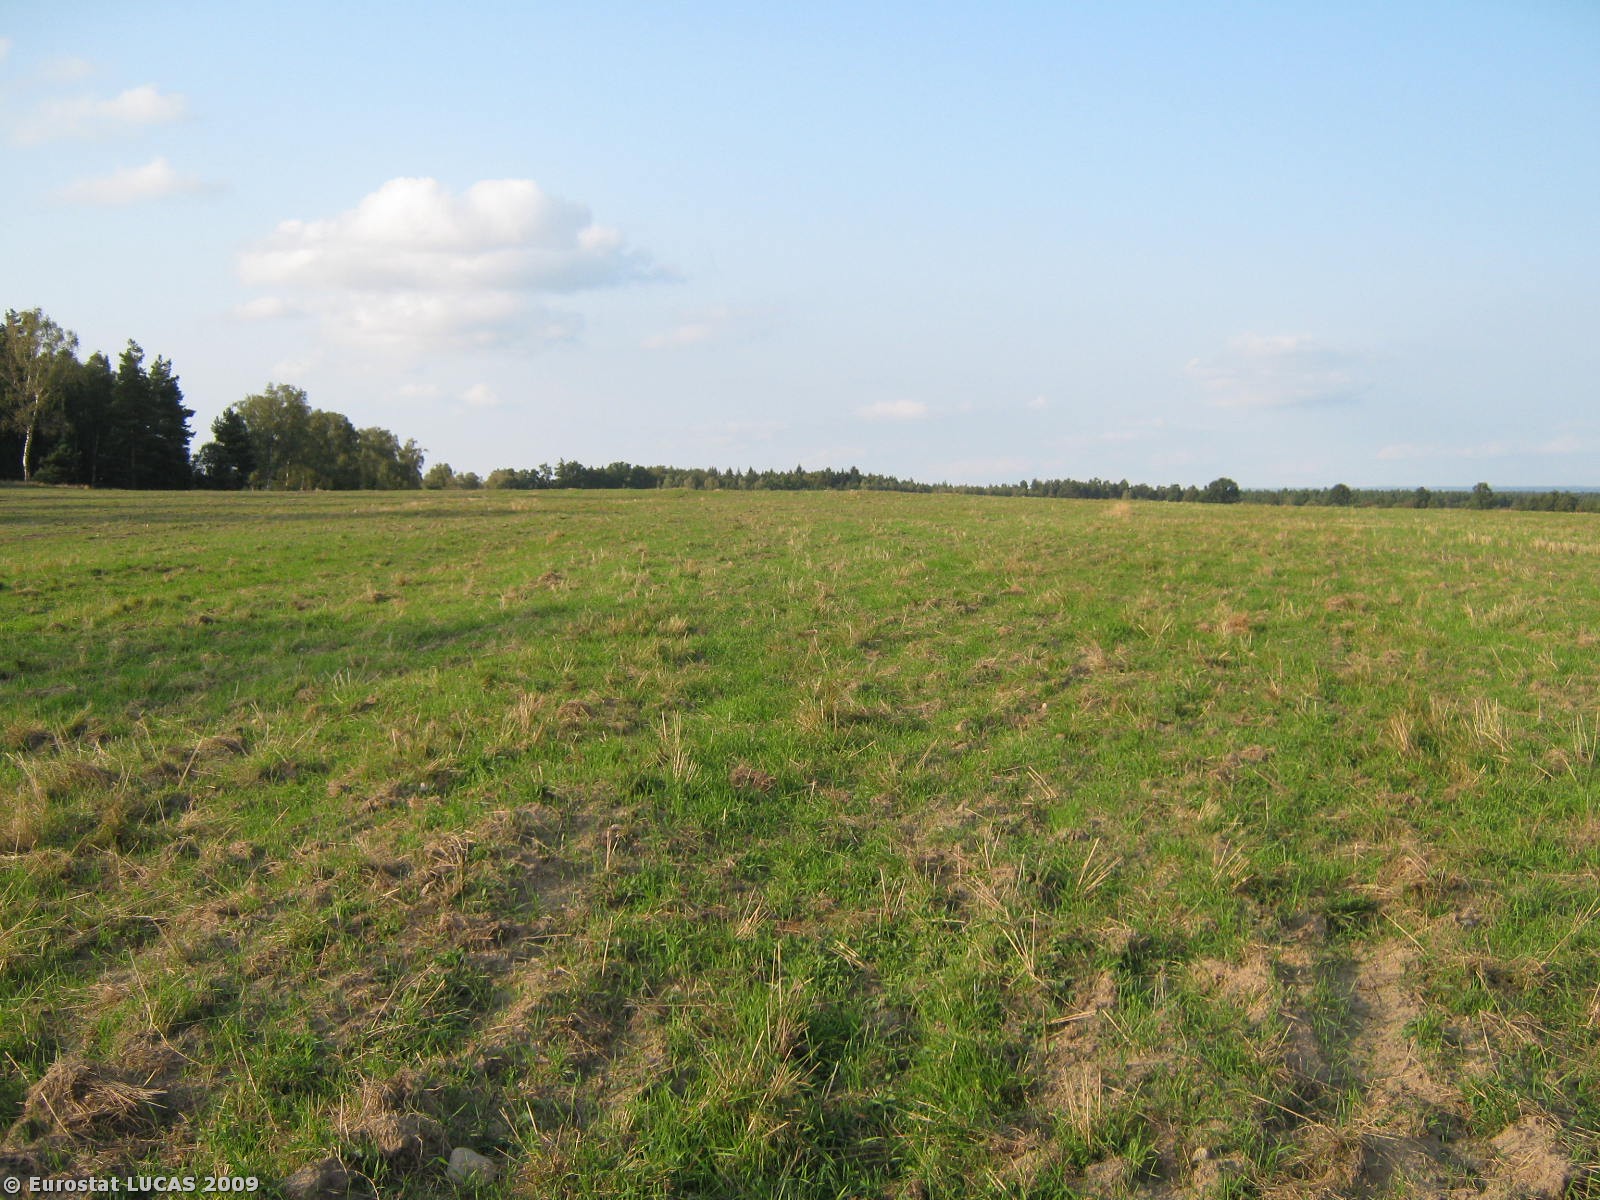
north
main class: Cropland
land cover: Triticale
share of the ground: < 10 %
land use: Agriculture (excluding fallow land and kitchen gardens)
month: September
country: PL
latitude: 53.7934
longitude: 16.3666
